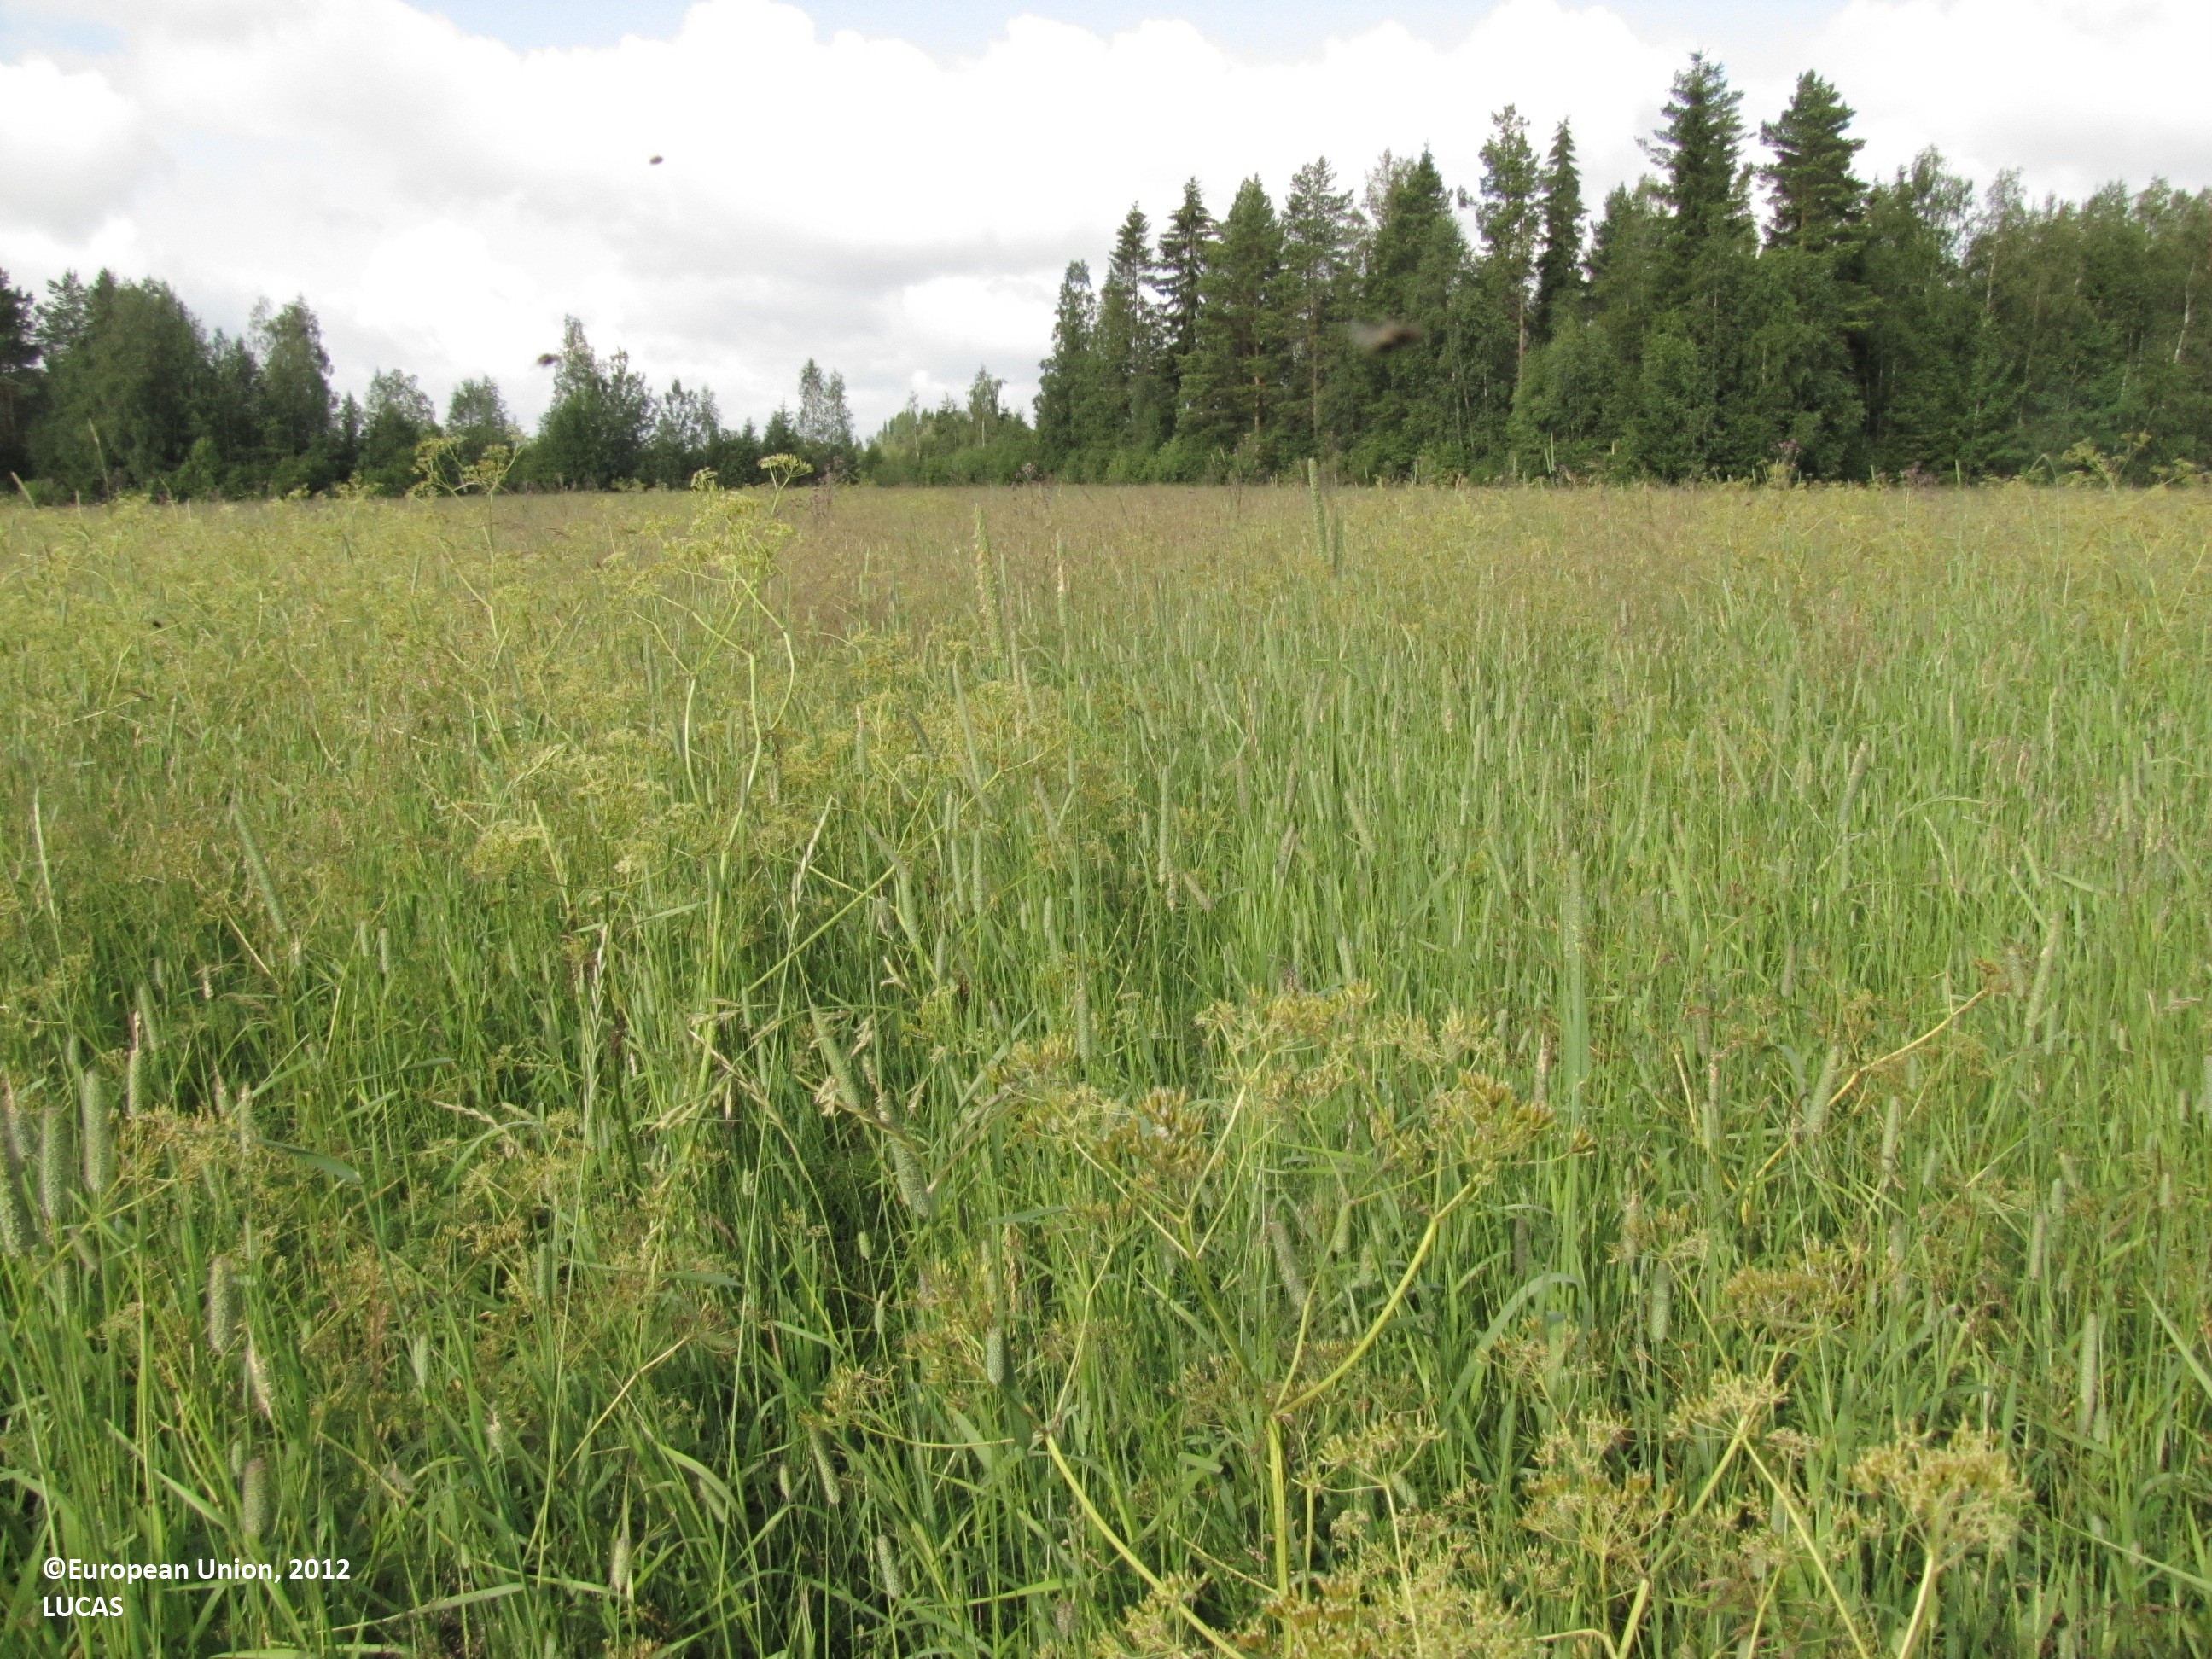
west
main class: Grassland
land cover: Spontaneously vegetated surfaces
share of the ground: > 75 %
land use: Agriculture (excluding fallow land and kitchen gardens)
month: July
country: FI
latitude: 62.6860
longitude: 23.0128
